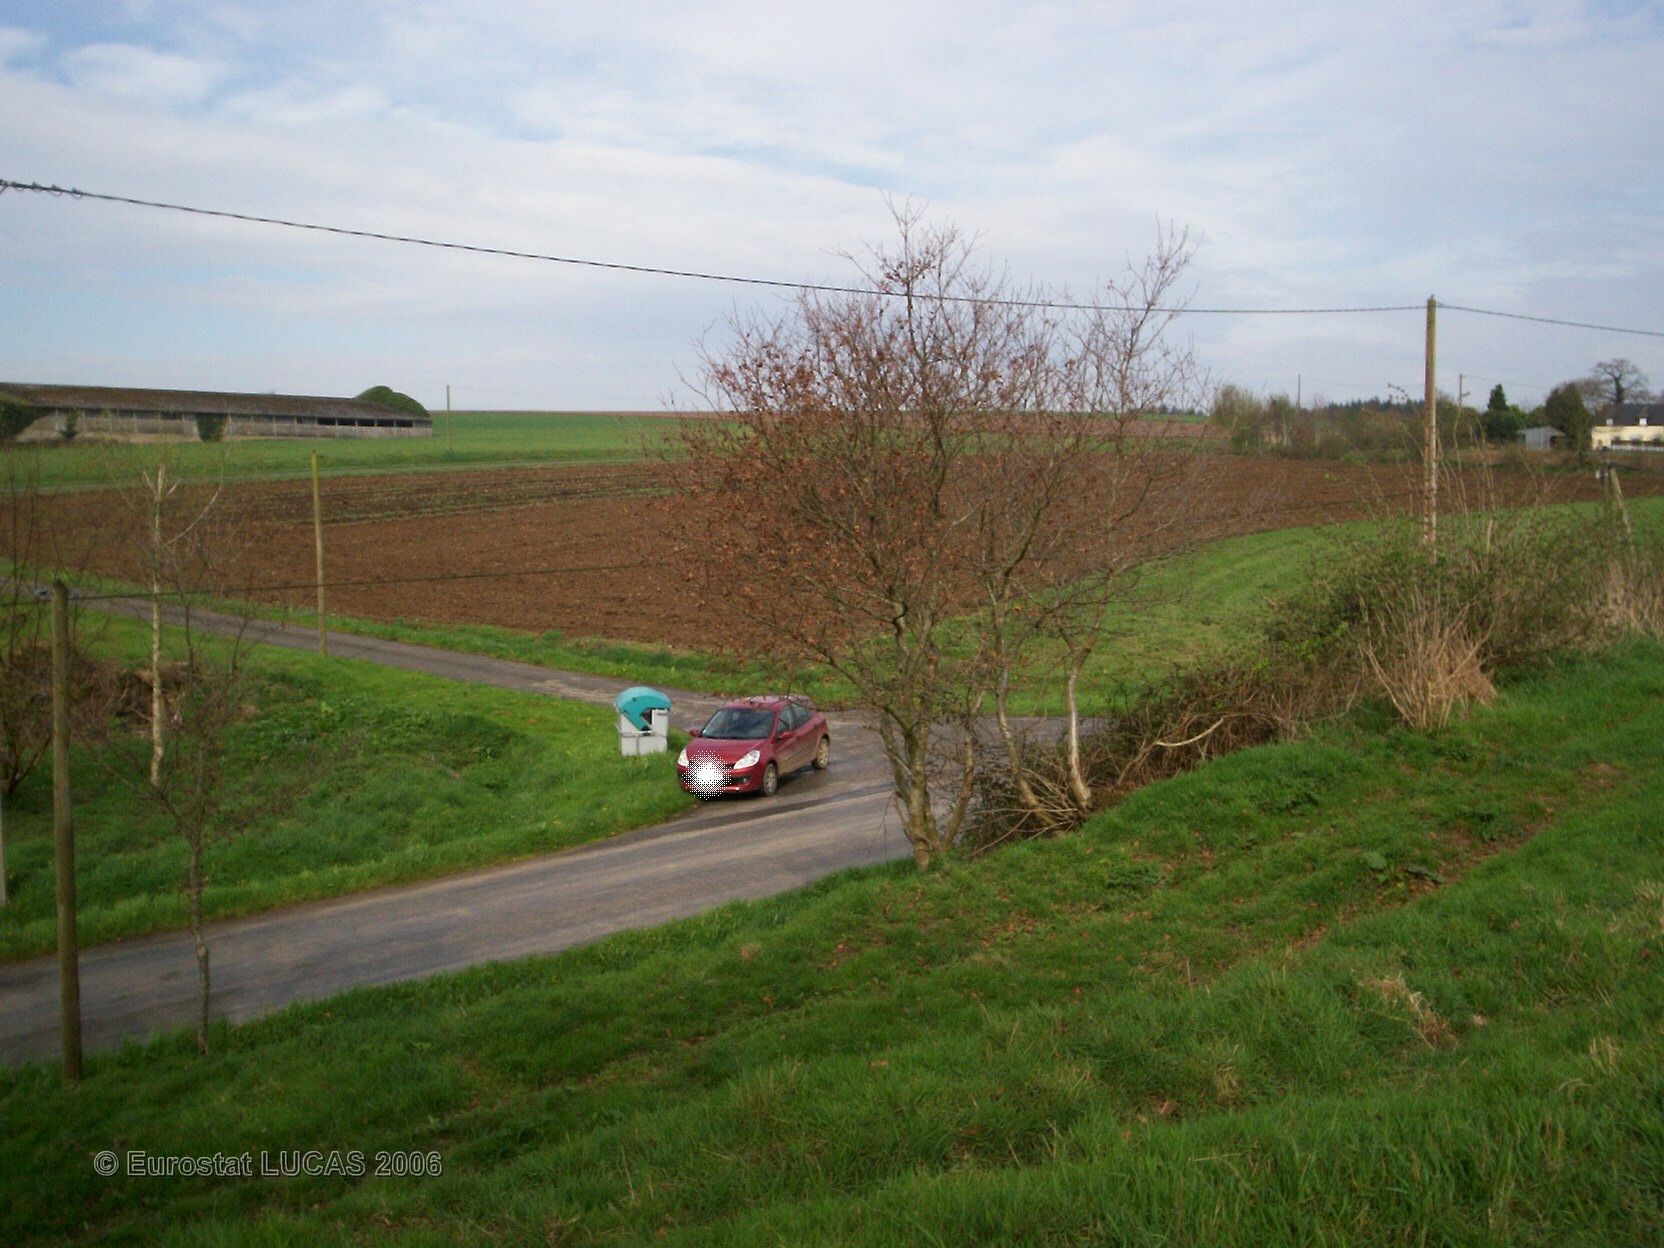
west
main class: Grassland
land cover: Grassland without tree/shrub cover
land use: Agriculture (excluding fallow land and kitchen gardens)
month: April
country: FR
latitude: 48.0475
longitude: -2.8771
